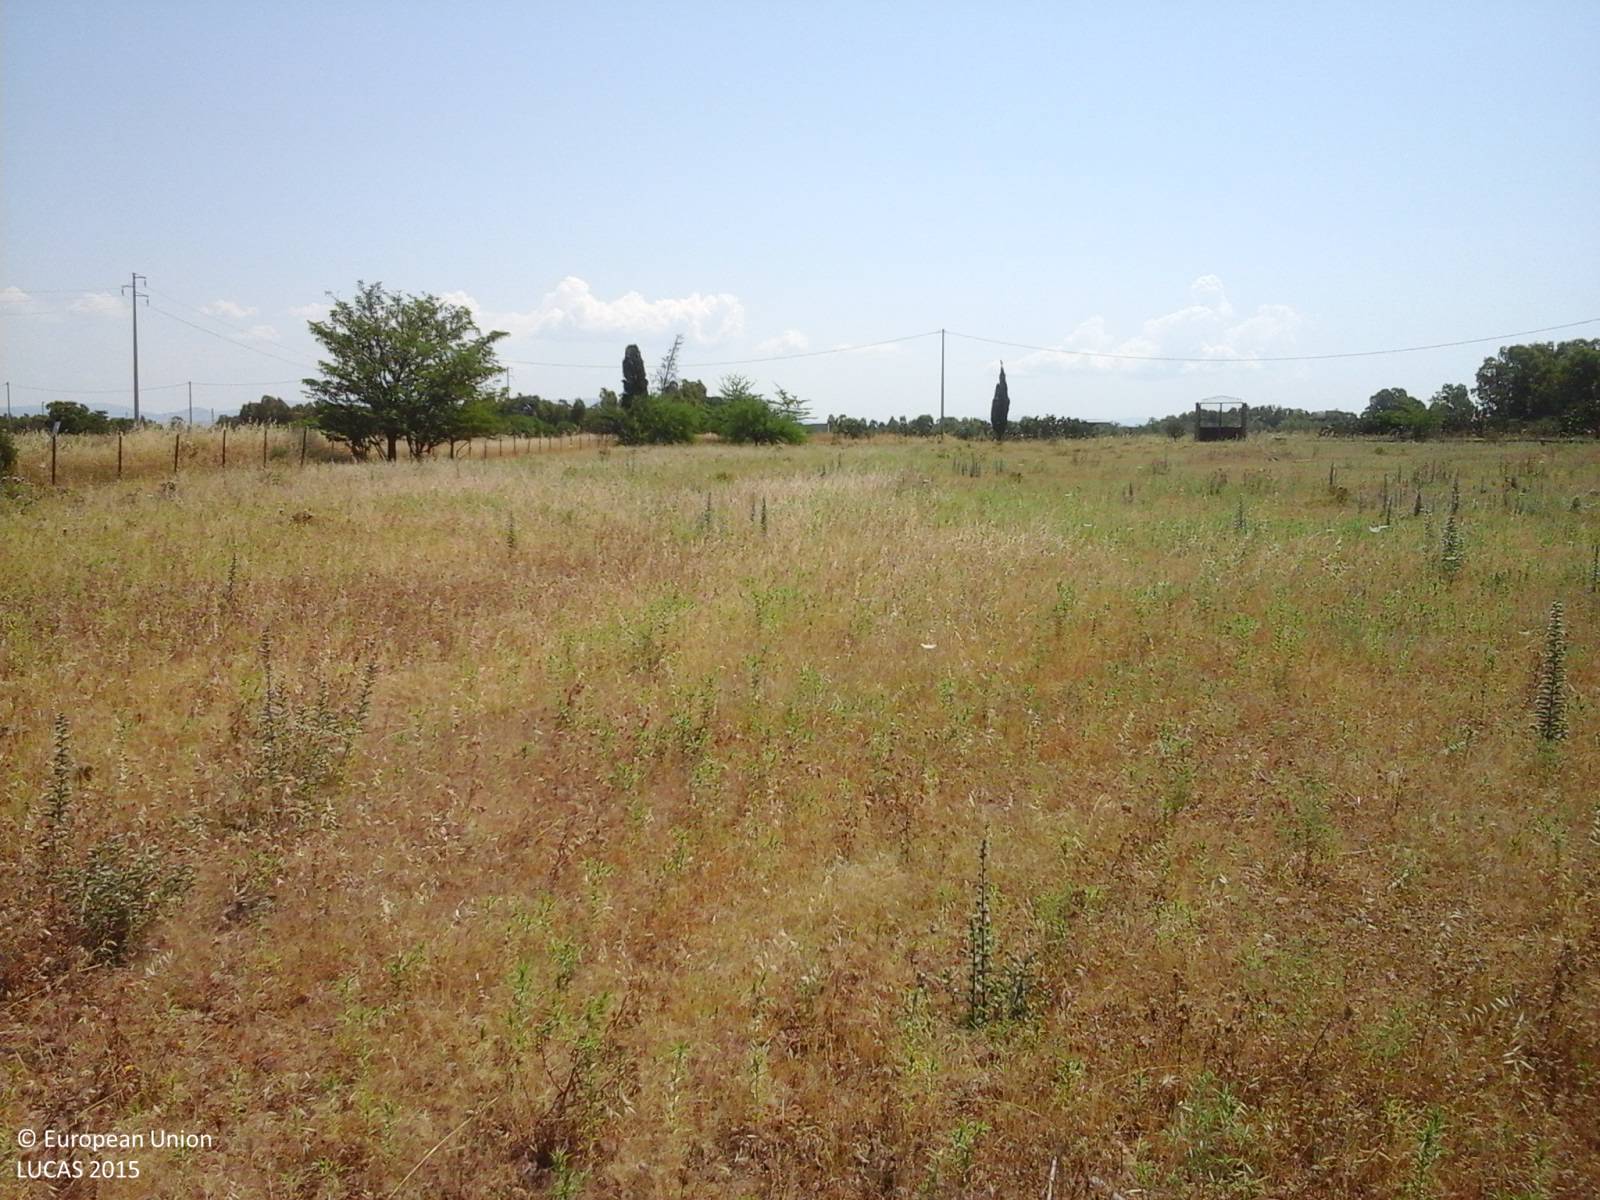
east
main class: Grassland
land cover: Grassland without tree/shrub cover
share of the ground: > 75 %
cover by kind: herbaceous plants 100 %
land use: Agriculture (excluding fallow land and kitchen gardens)
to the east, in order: Grassland without tree/shrub cover; Fences; Grass margins; Tracks; Grass margins; Managed hedges; Fences; Electric lines; Temporary grasslands; Fences; Lines of trees; Tracks; Olive groves; Tracks; Lines of trees
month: June
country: IT
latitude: 39.3012
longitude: 8.9051
